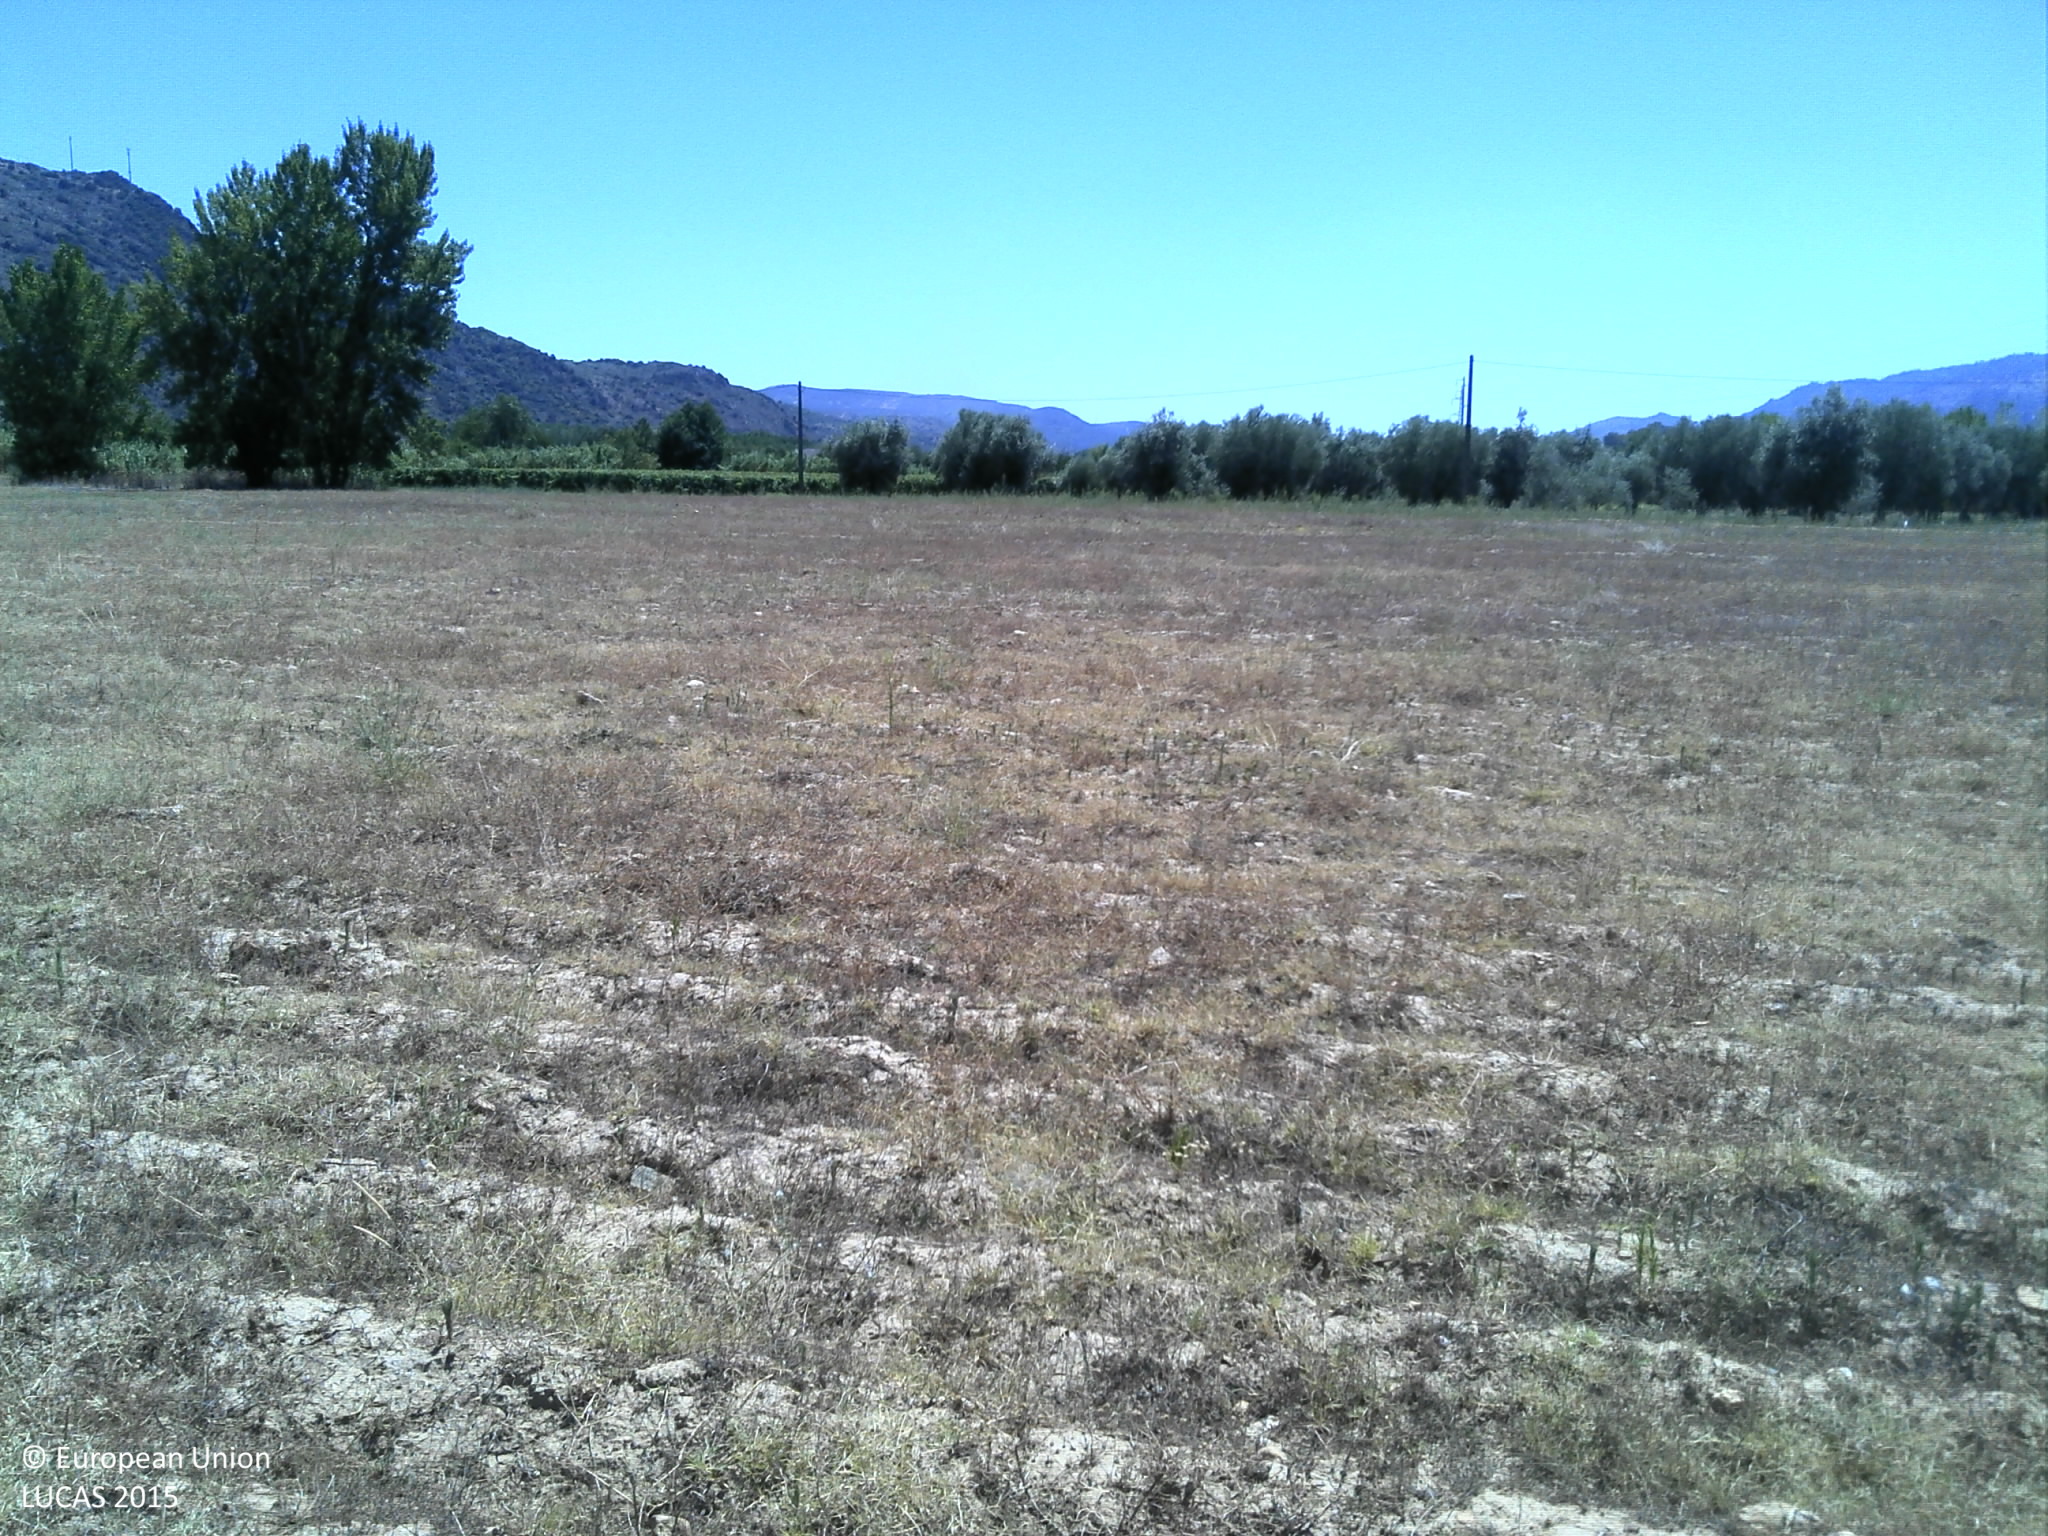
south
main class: Grassland
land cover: Spontaneously vegetated surfaces
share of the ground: 50 - 75 %
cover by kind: herbaceous plants 60 %, unconsolidated bare surface 40 %
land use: Fallow land
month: July
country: PT
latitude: 41.2436
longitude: -7.0929
